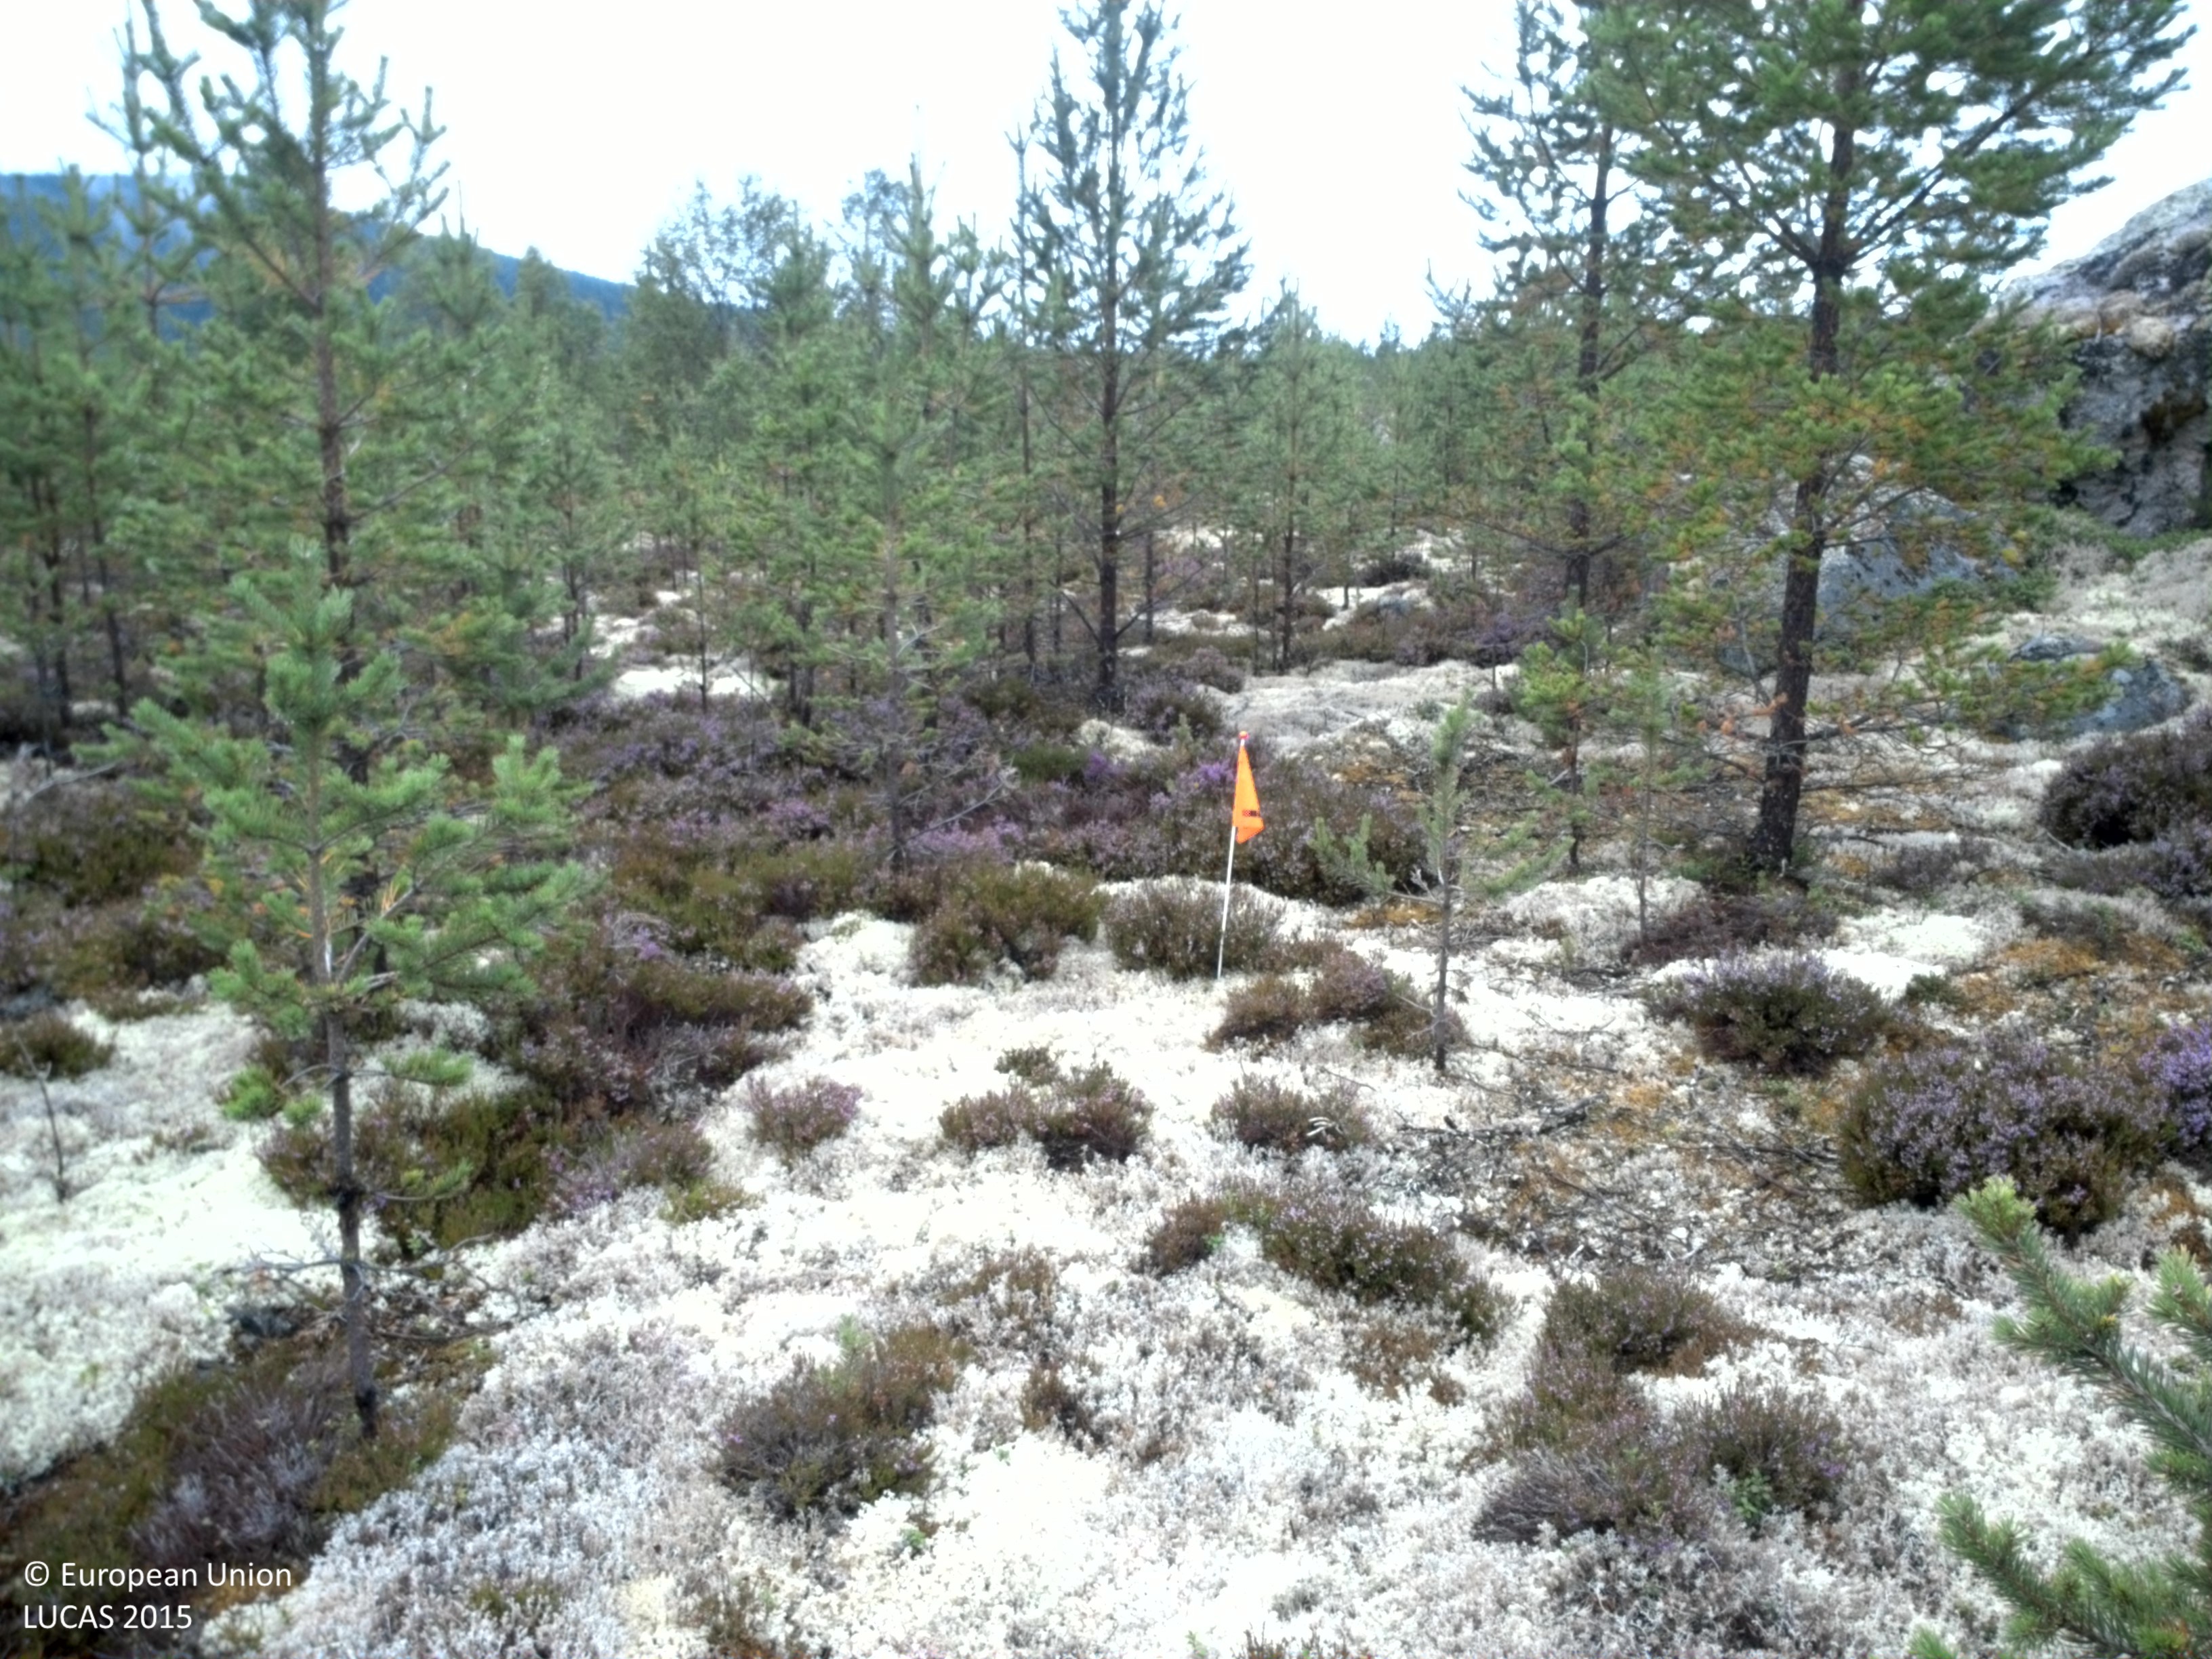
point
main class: Woodland
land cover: Pine dominated coniferous woodland
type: boreal forest
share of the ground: 10 - 25 %
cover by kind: shrubs 45 %, lichens and mosses 25 %, coniferous forest trees 20 %, consolidated bare surface 10 %
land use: Forestry
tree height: < 5 m
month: August
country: SE
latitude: 61.8282
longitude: 14.9009
